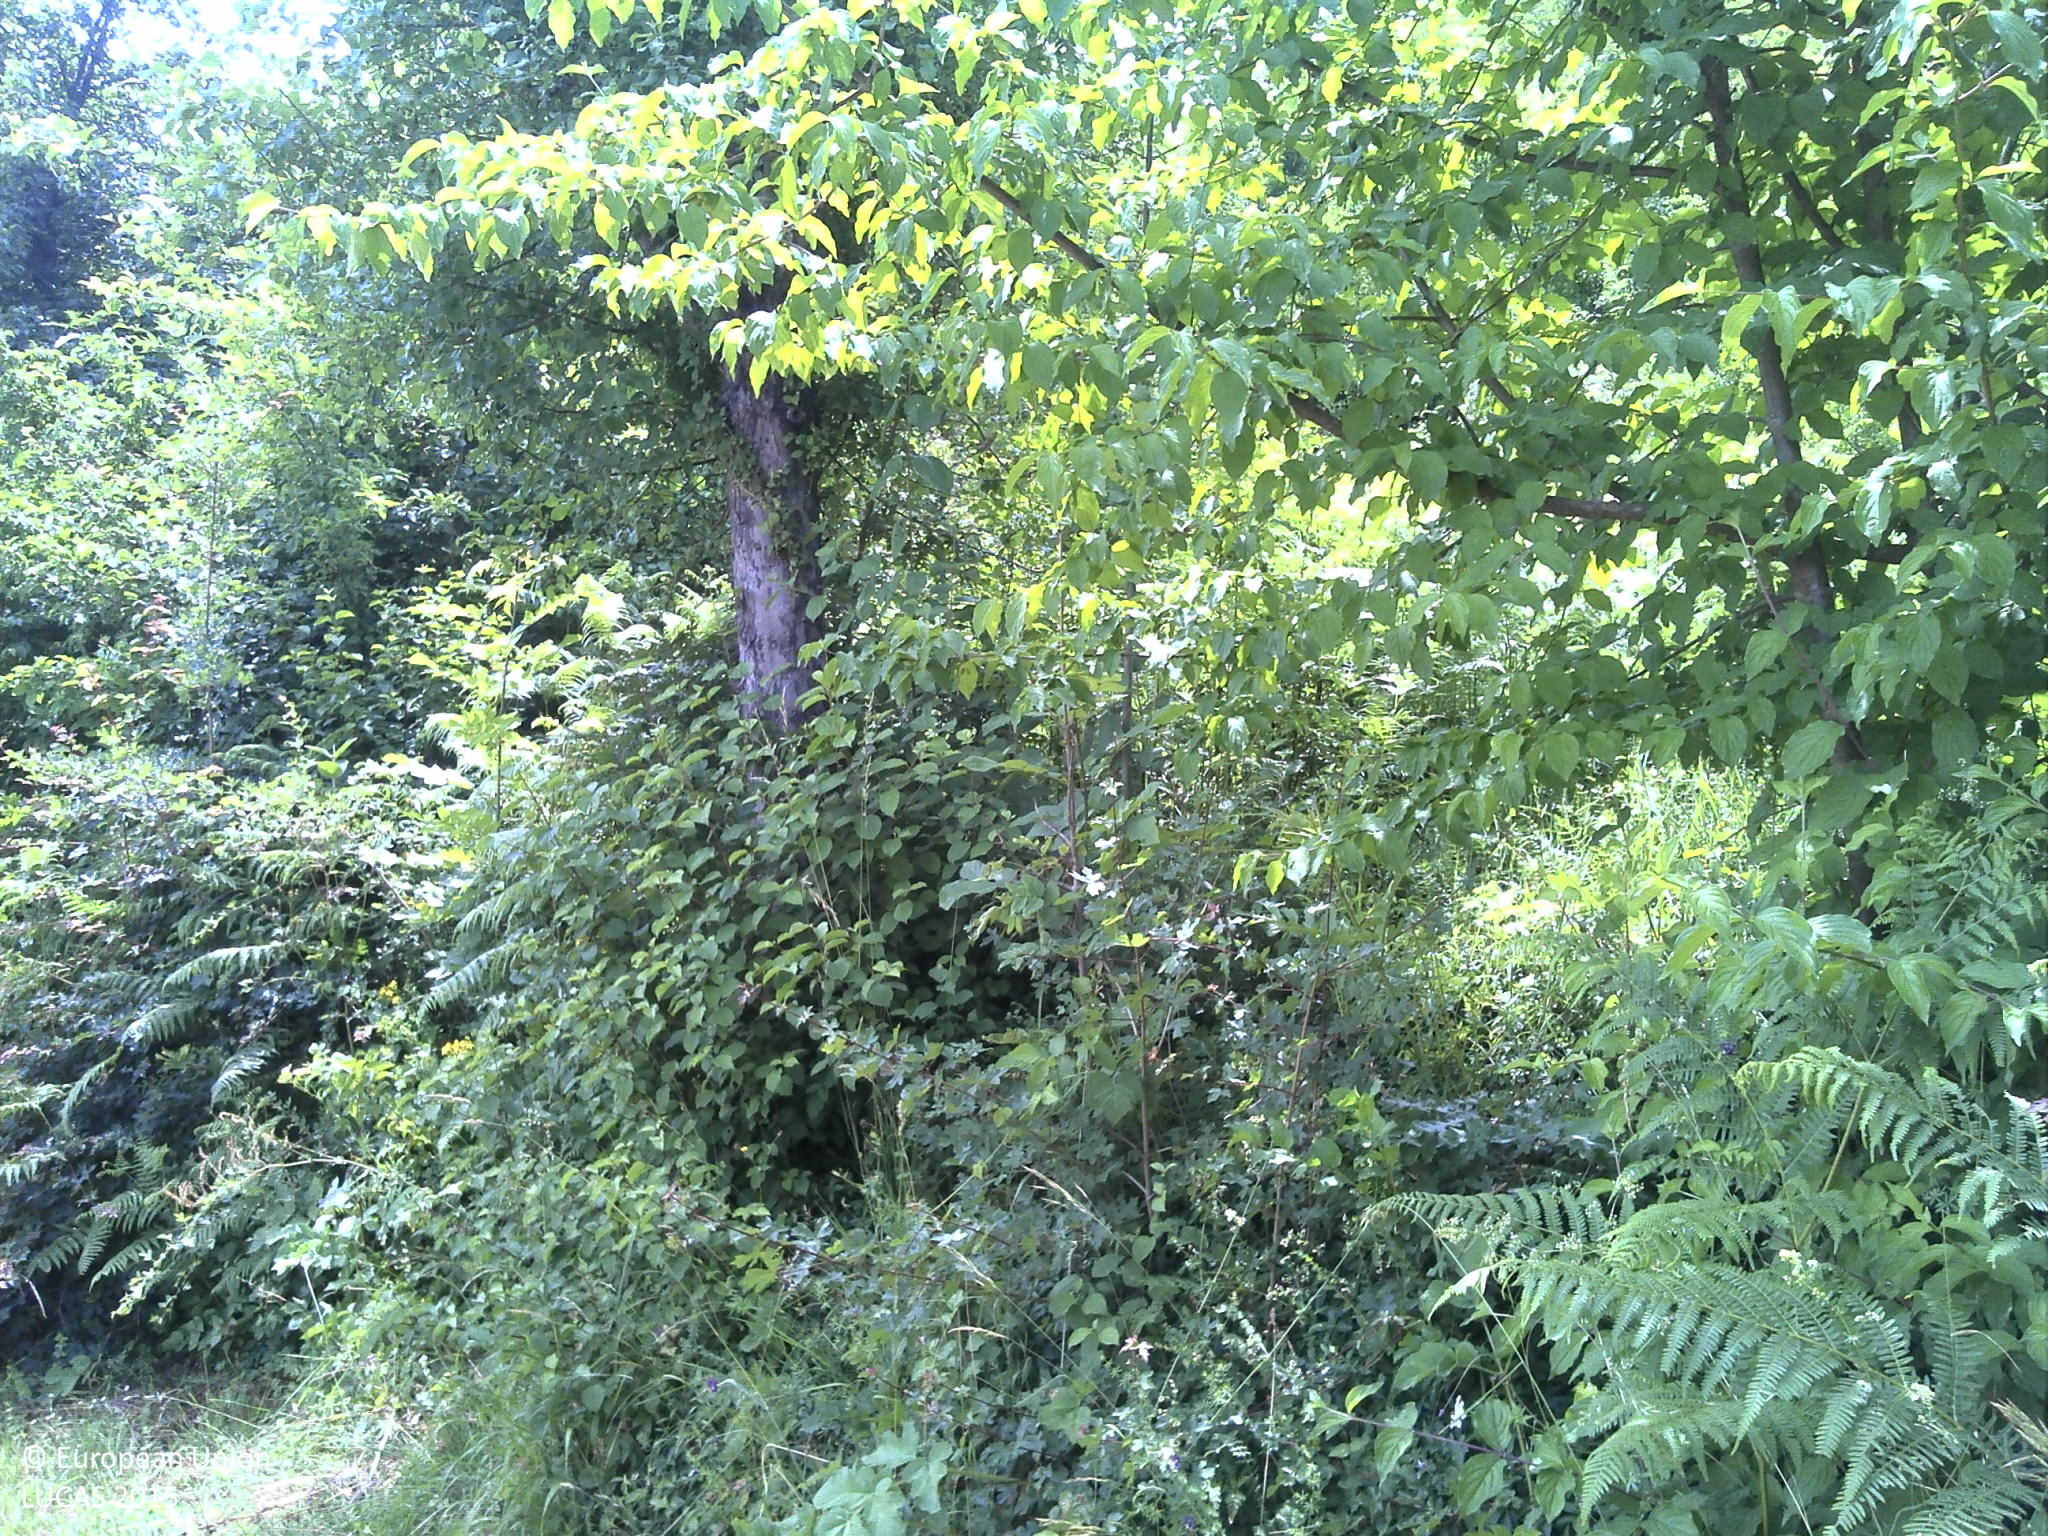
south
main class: Woodland
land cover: Broadleaved woodland
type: beech forest
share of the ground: > 75 %
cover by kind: broadleaved forest trees 100 %
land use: Semi-natural and natural areas not in use
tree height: > 5 m
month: June
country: HR
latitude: 44.5430
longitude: 15.9220
